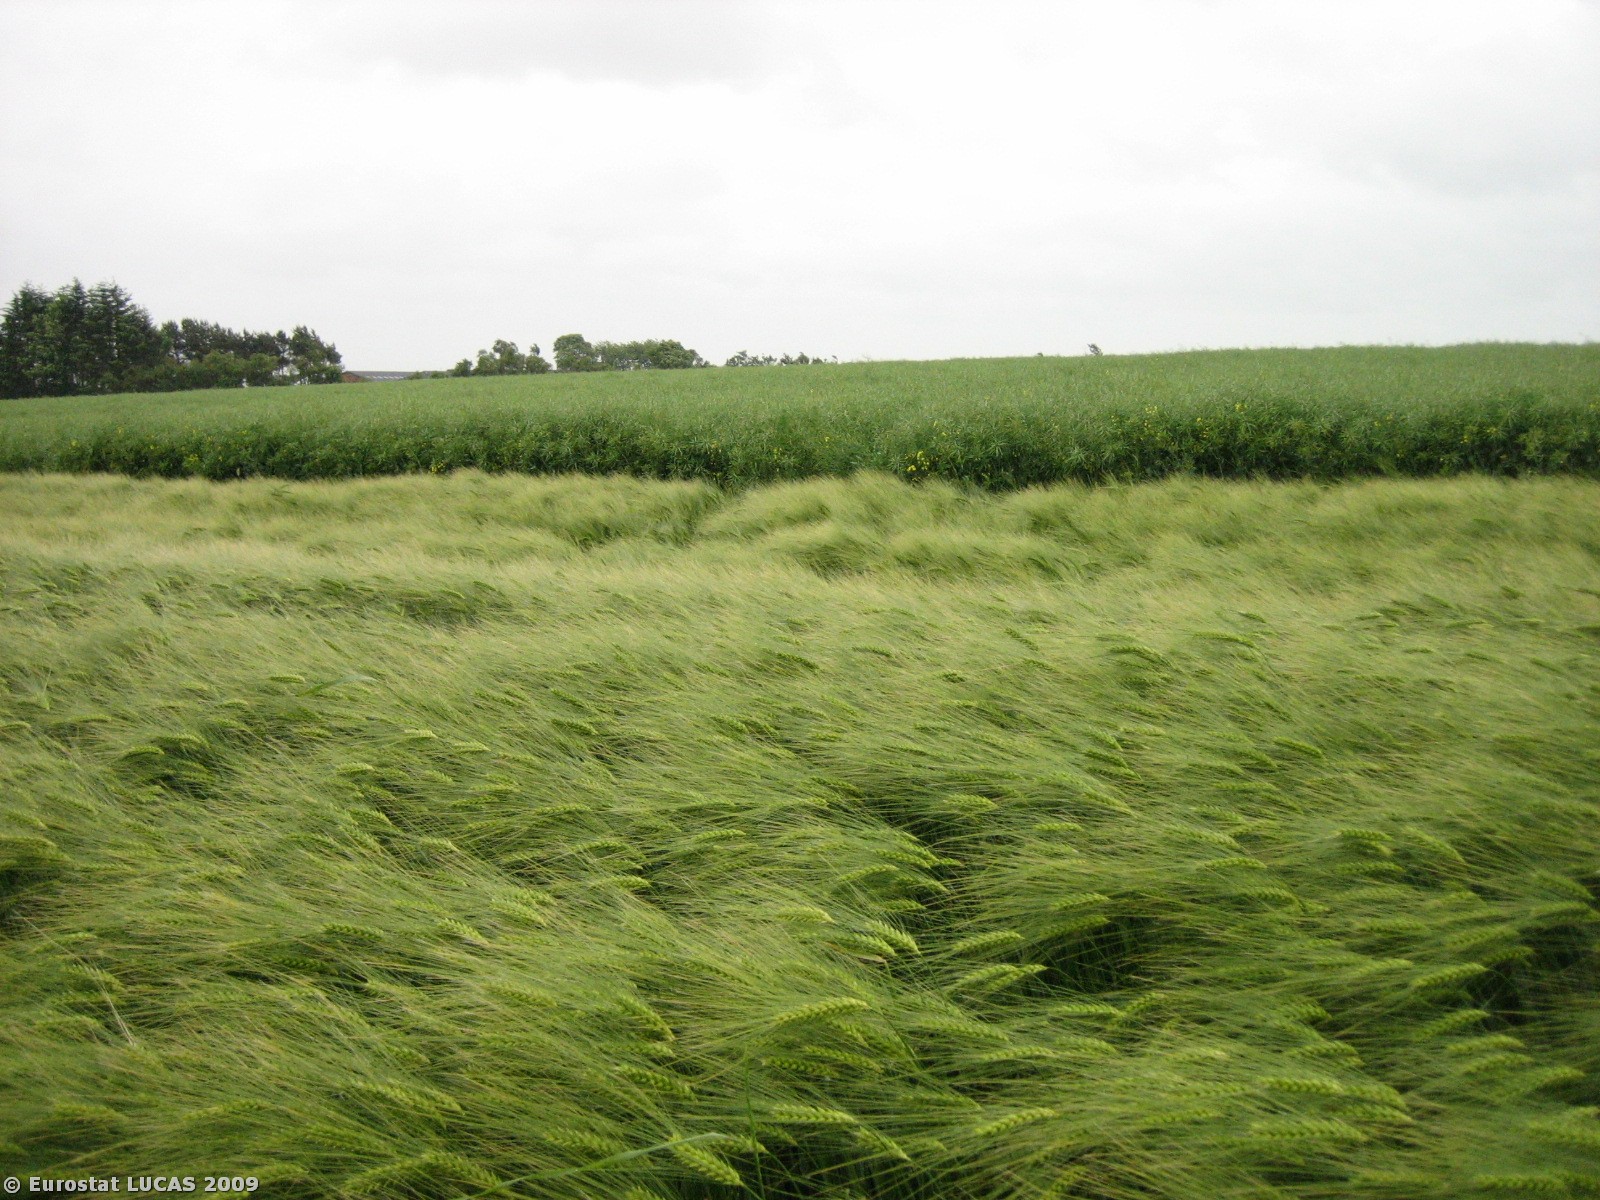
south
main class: Cropland
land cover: Rape and turnip rape
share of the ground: > 75 %
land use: Agriculture (excluding fallow land and kitchen gardens)
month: June
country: DK
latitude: 56.0979
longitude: 10.0161
